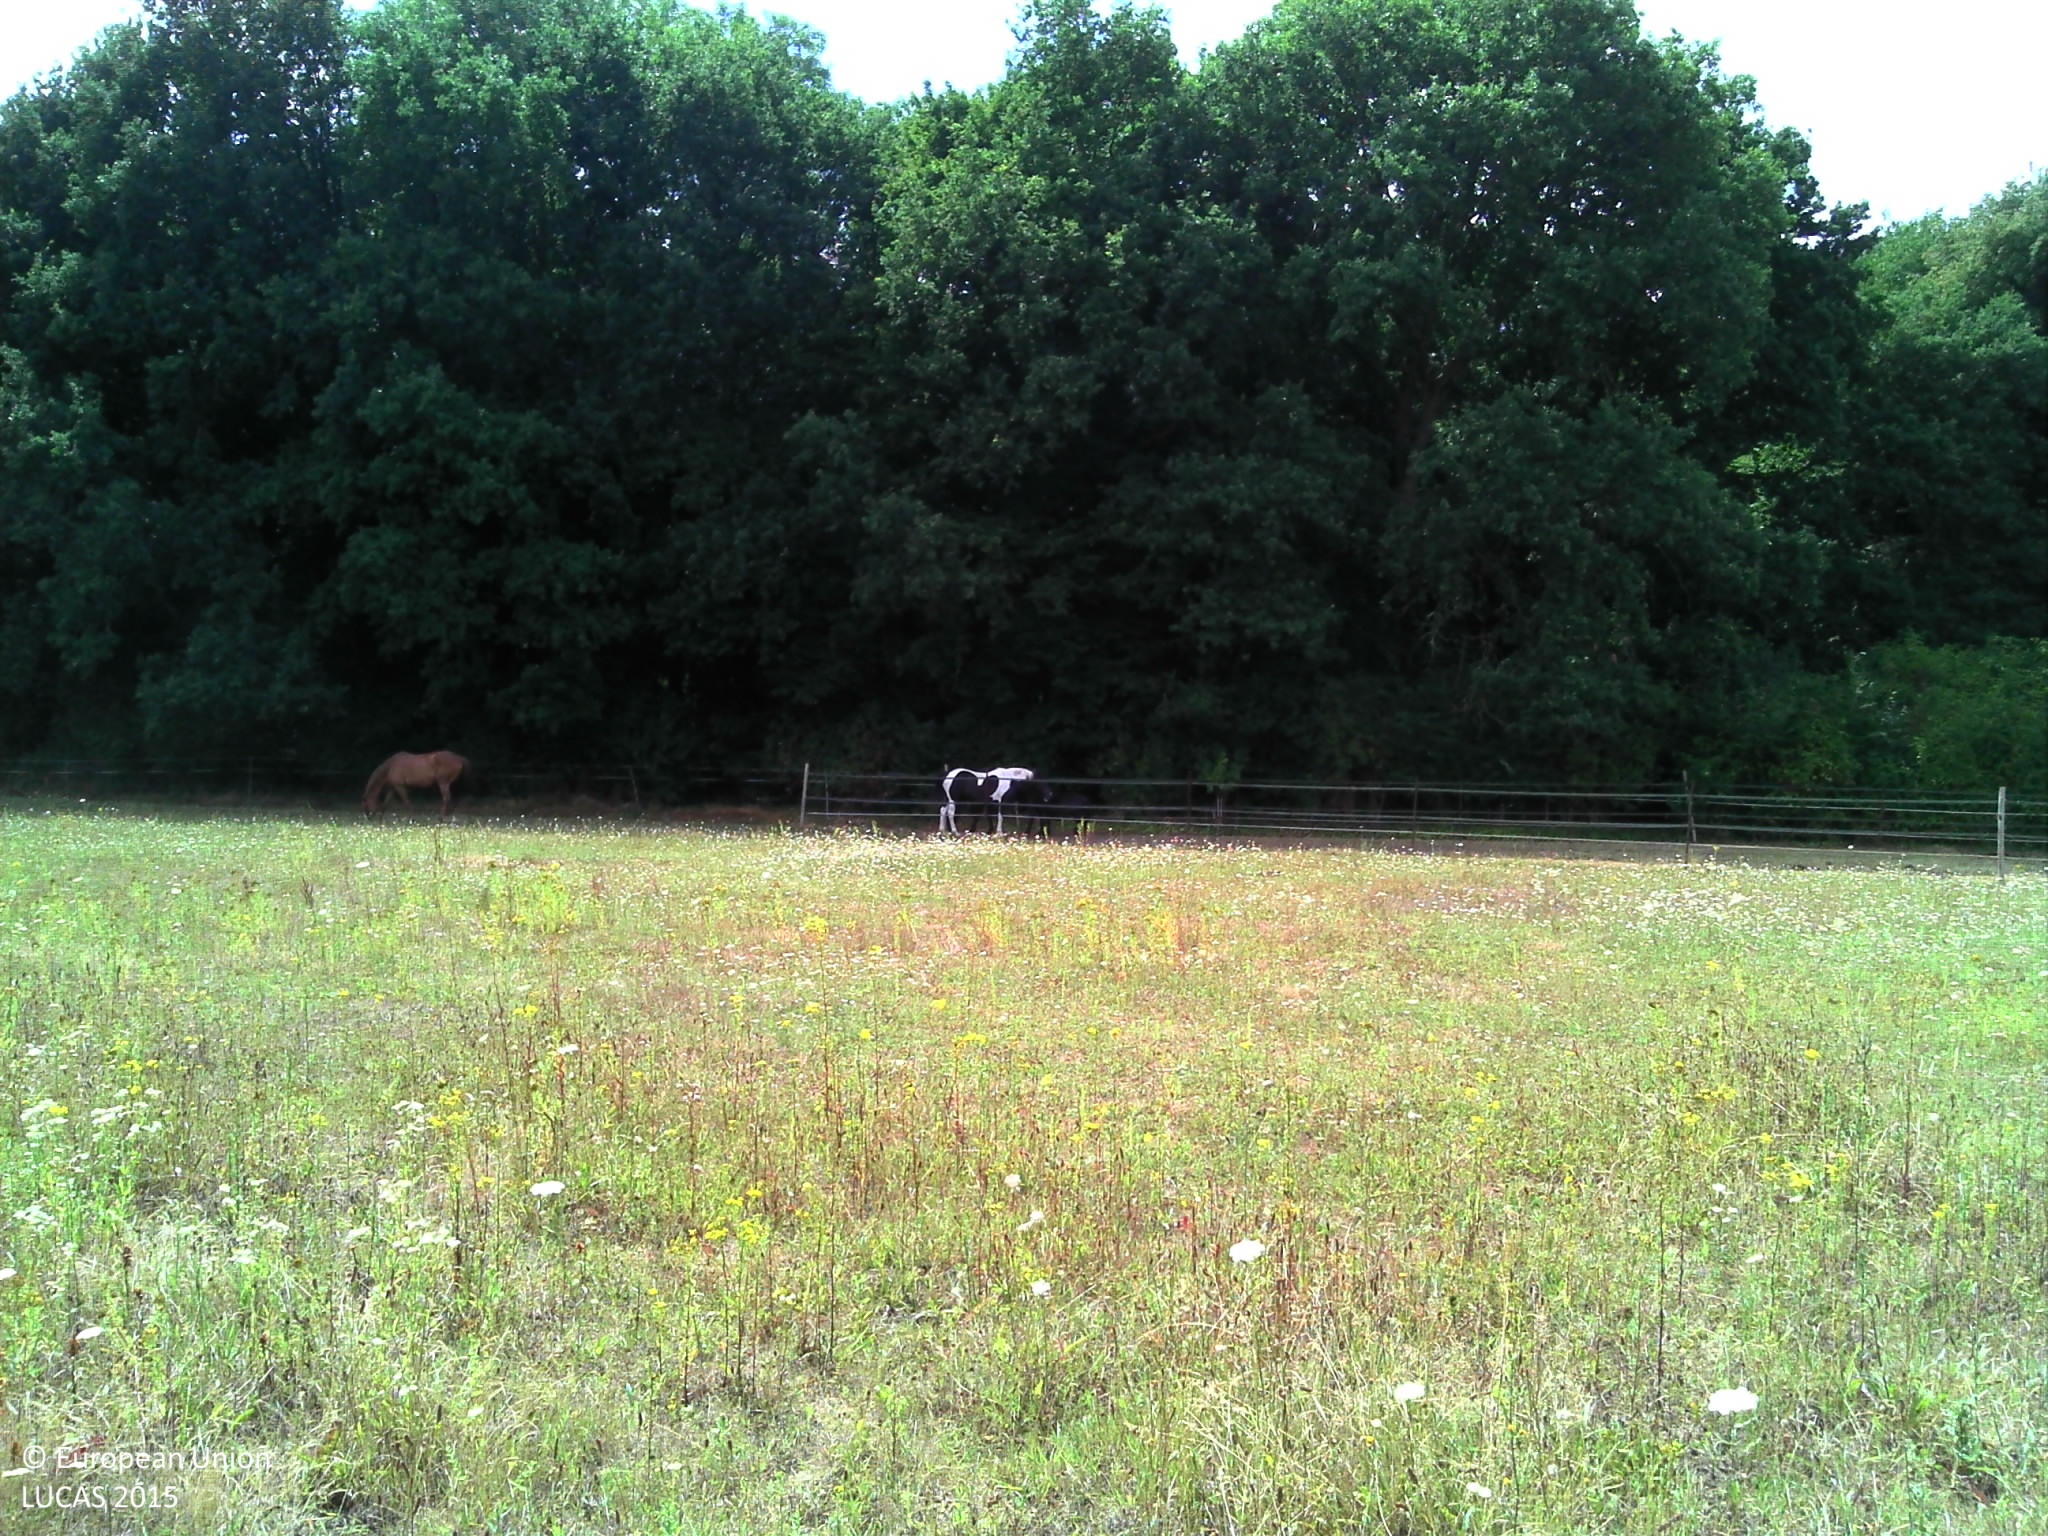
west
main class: Grassland
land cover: Grassland without tree/shrub cover
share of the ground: > 75 %
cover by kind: herbaceous plants 100 %
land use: Agriculture (excluding fallow land and kitchen gardens)
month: July
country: FR
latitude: 49.1471
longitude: 2.5720
